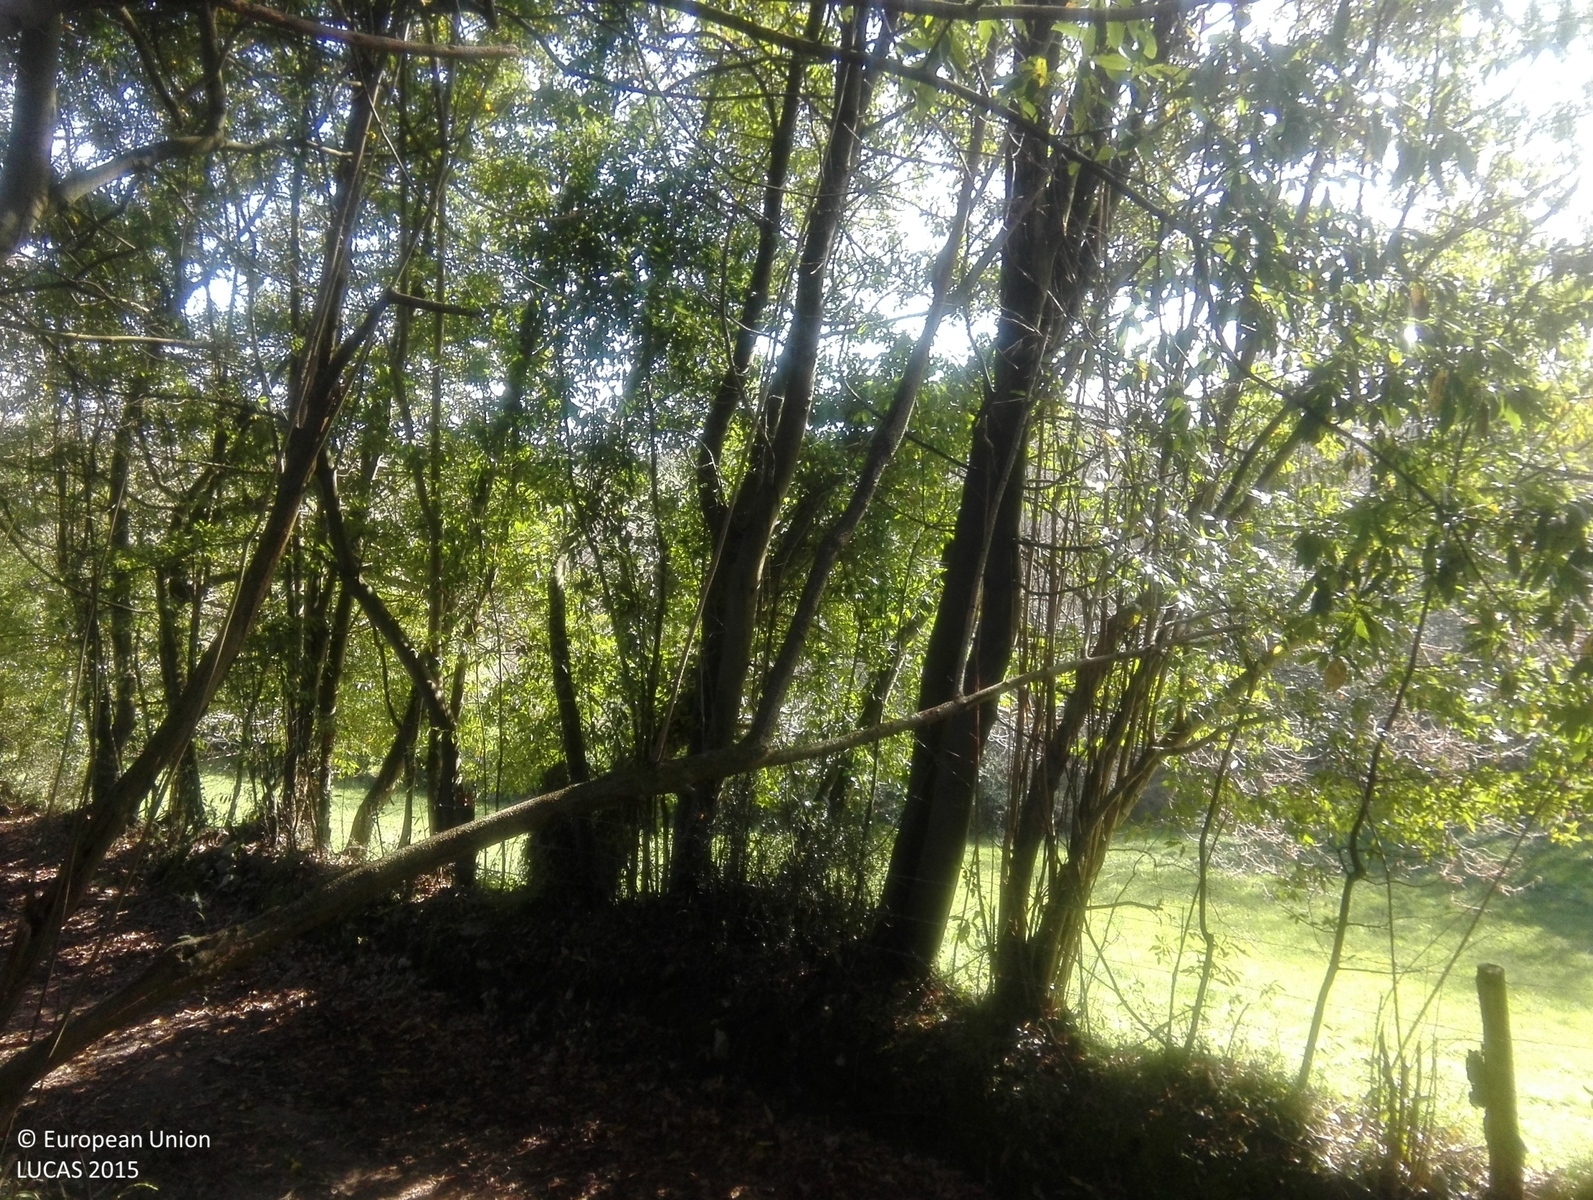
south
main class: Woodland
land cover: Broadleaved woodland
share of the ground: > 75 %
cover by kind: broadleaved forest trees 100 %
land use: Semi-natural and natural areas not in use
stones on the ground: < 10 %
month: April
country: ES
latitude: 43.4139
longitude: -5.6320
